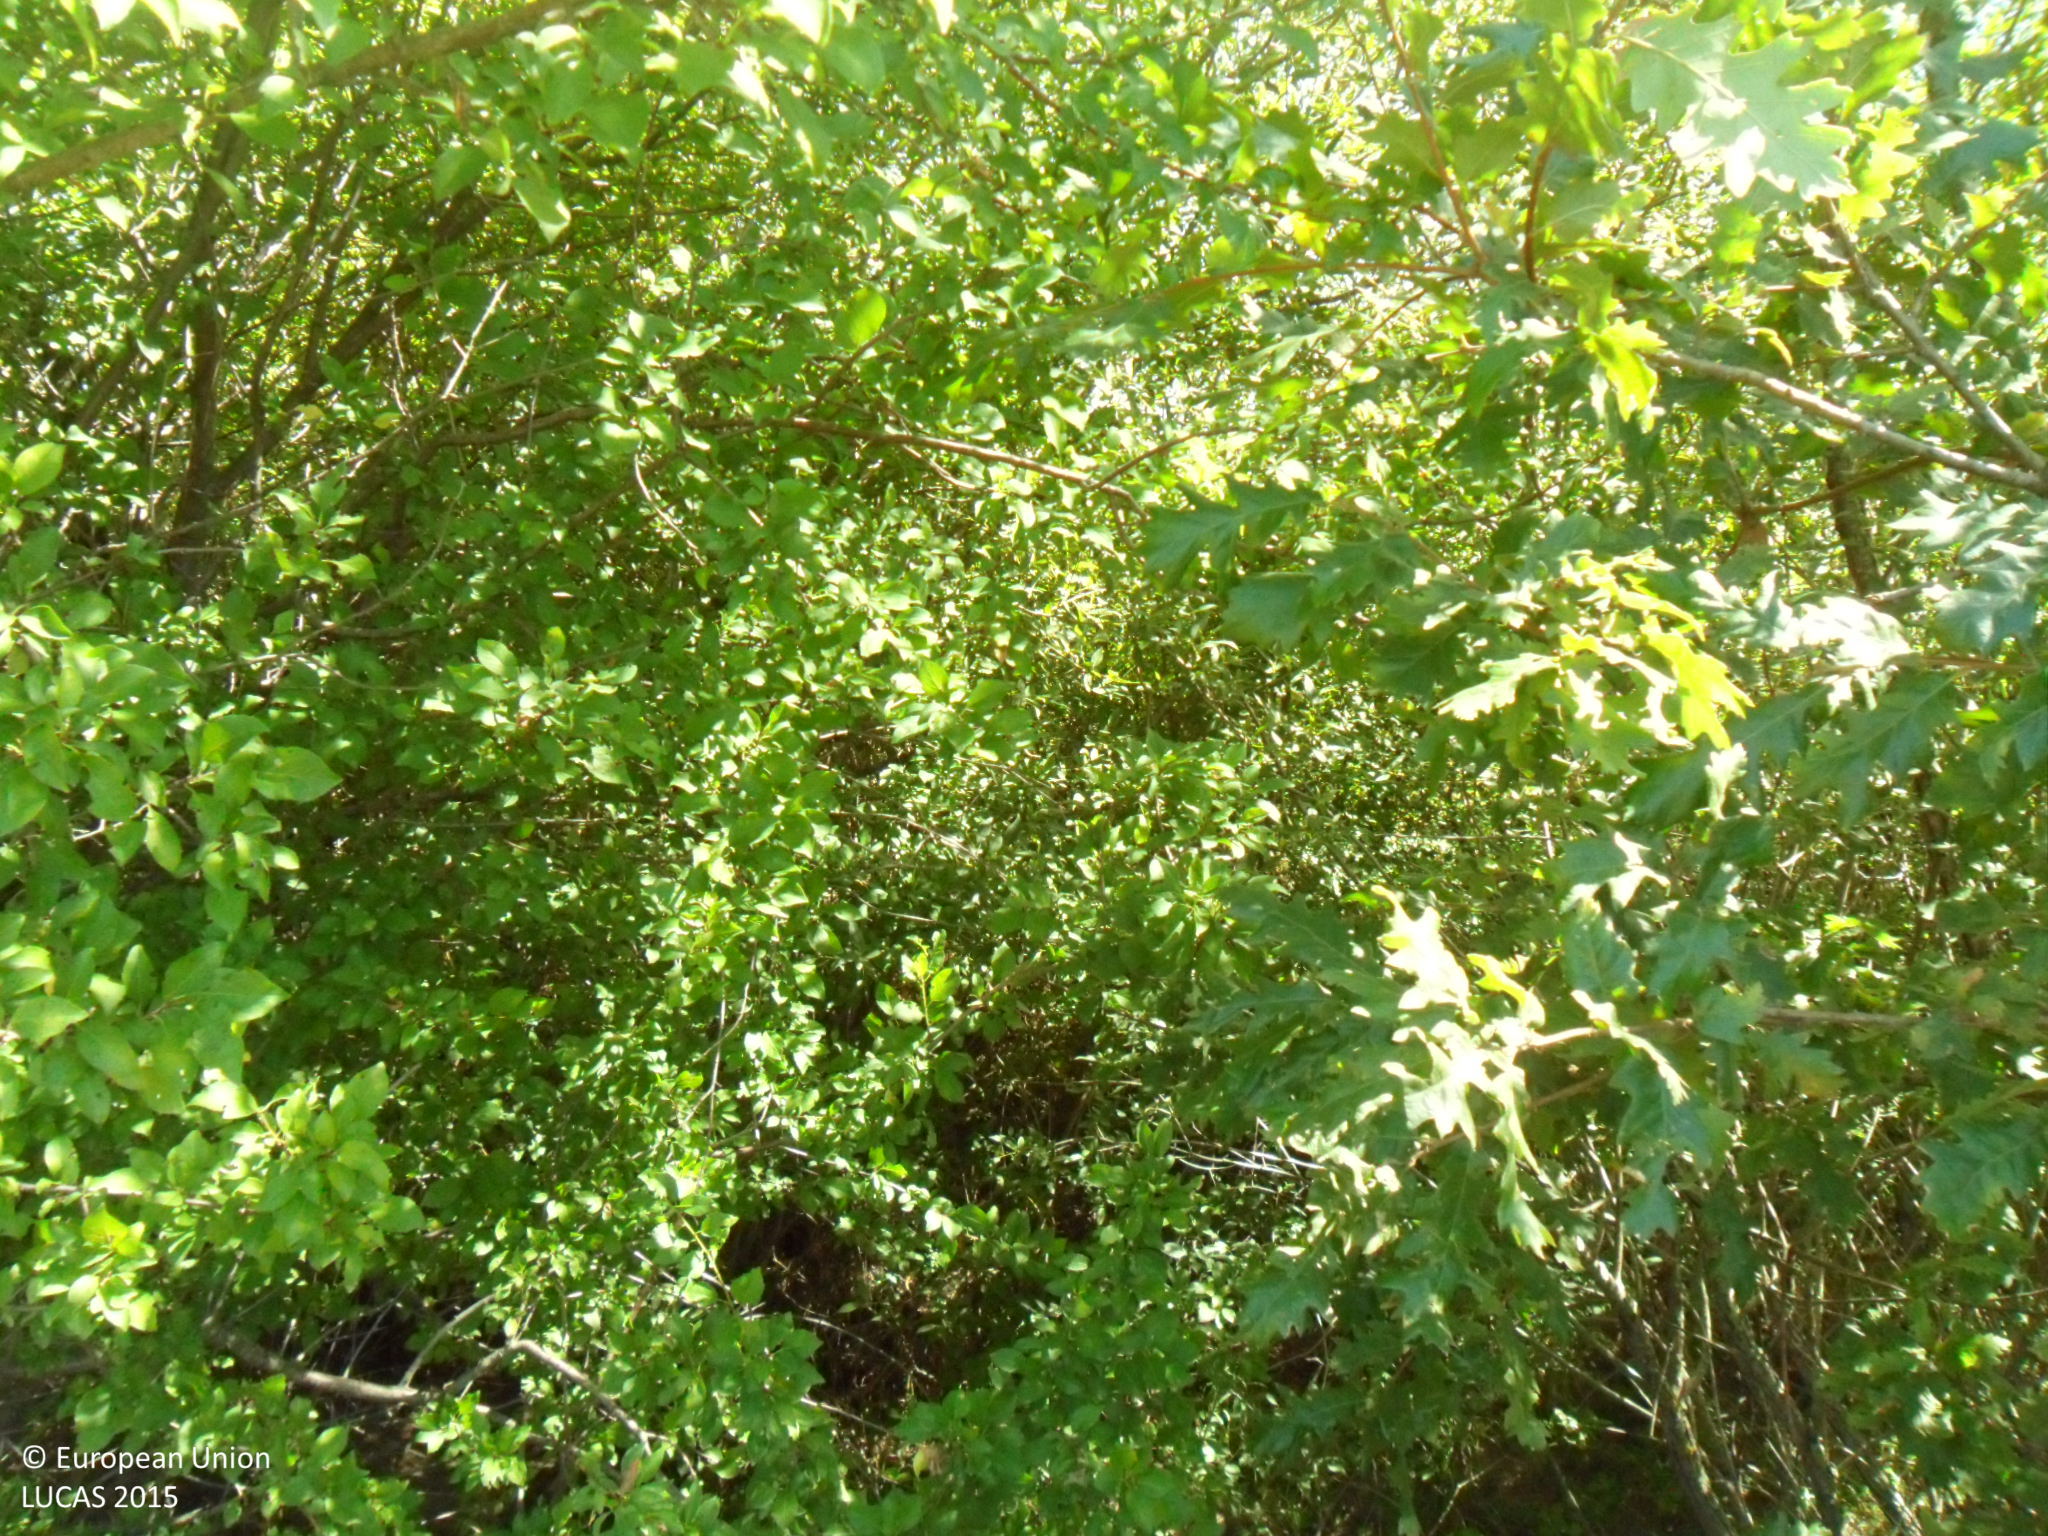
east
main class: Woodland
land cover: Broadleaved woodland
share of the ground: > 75 %
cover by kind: broadleaved forest trees 70 %, shrubs 25 %, herbaceous plants 5 %
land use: Semi-natural and natural areas not in use
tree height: > 5 m
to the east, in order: Broadleaved woodland; Ditches and canals; Broadleaved woodland; Sunflower
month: September
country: BG
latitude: 43.2629
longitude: 26.8021
